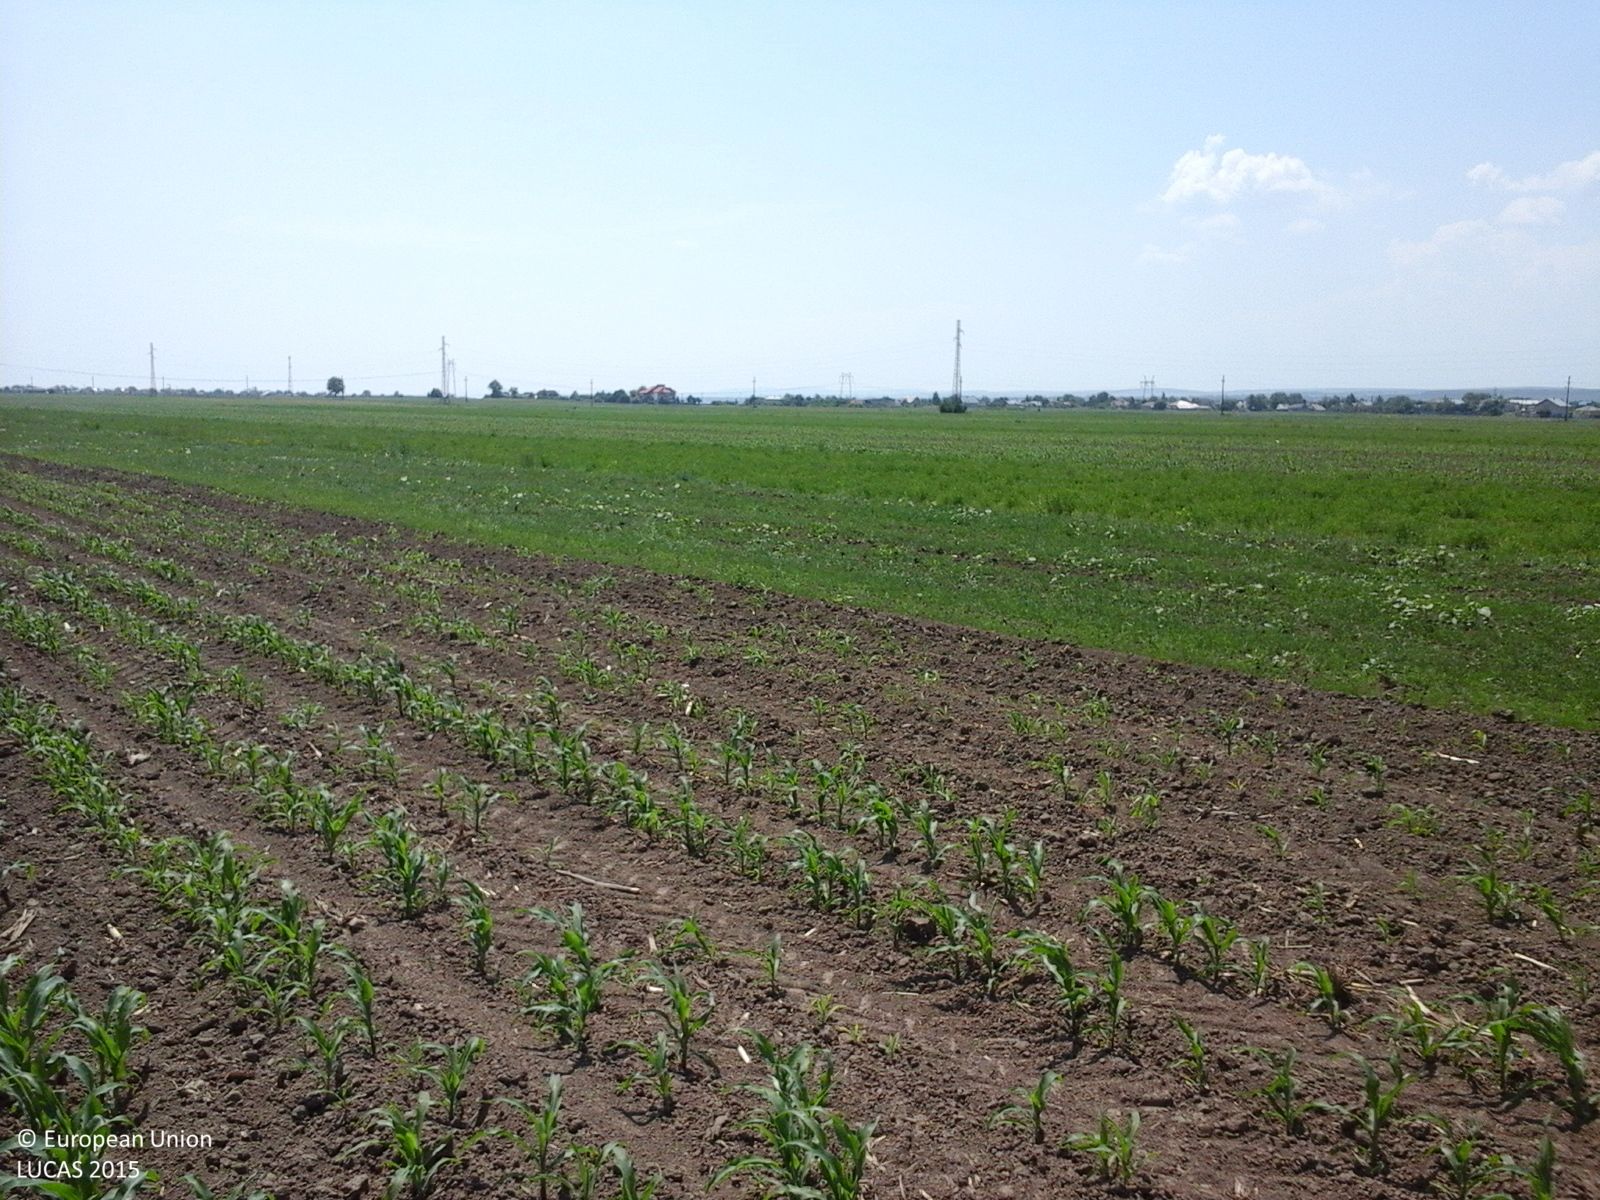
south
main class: Cropland
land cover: Maize
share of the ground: 25 - 50 %
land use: Agriculture (excluding fallow land and kitchen gardens)
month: June
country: RO
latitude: 47.0426
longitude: 26.8503
